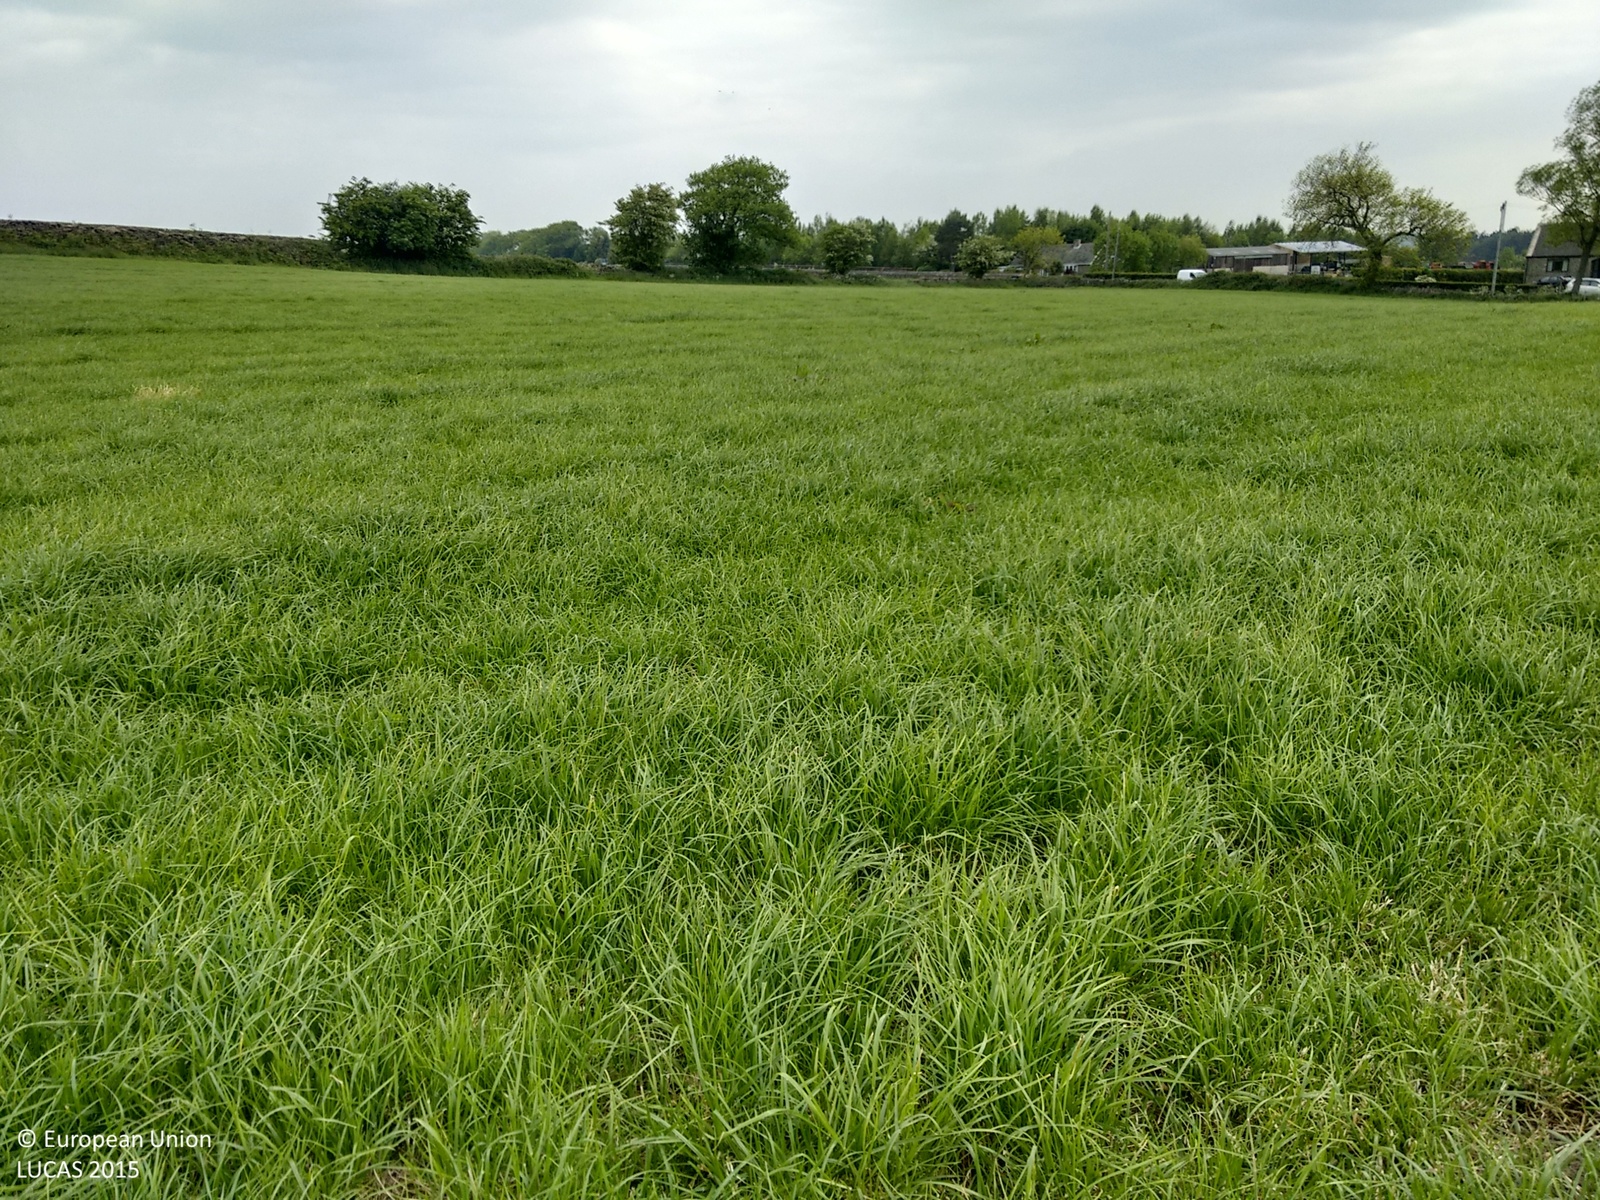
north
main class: Cropland
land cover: Temporary grasslands
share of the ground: > 75 %
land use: Agriculture (excluding fallow land and kitchen gardens)
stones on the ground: < 10 %
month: June
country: GB
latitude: 54.0612
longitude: -1.5854
